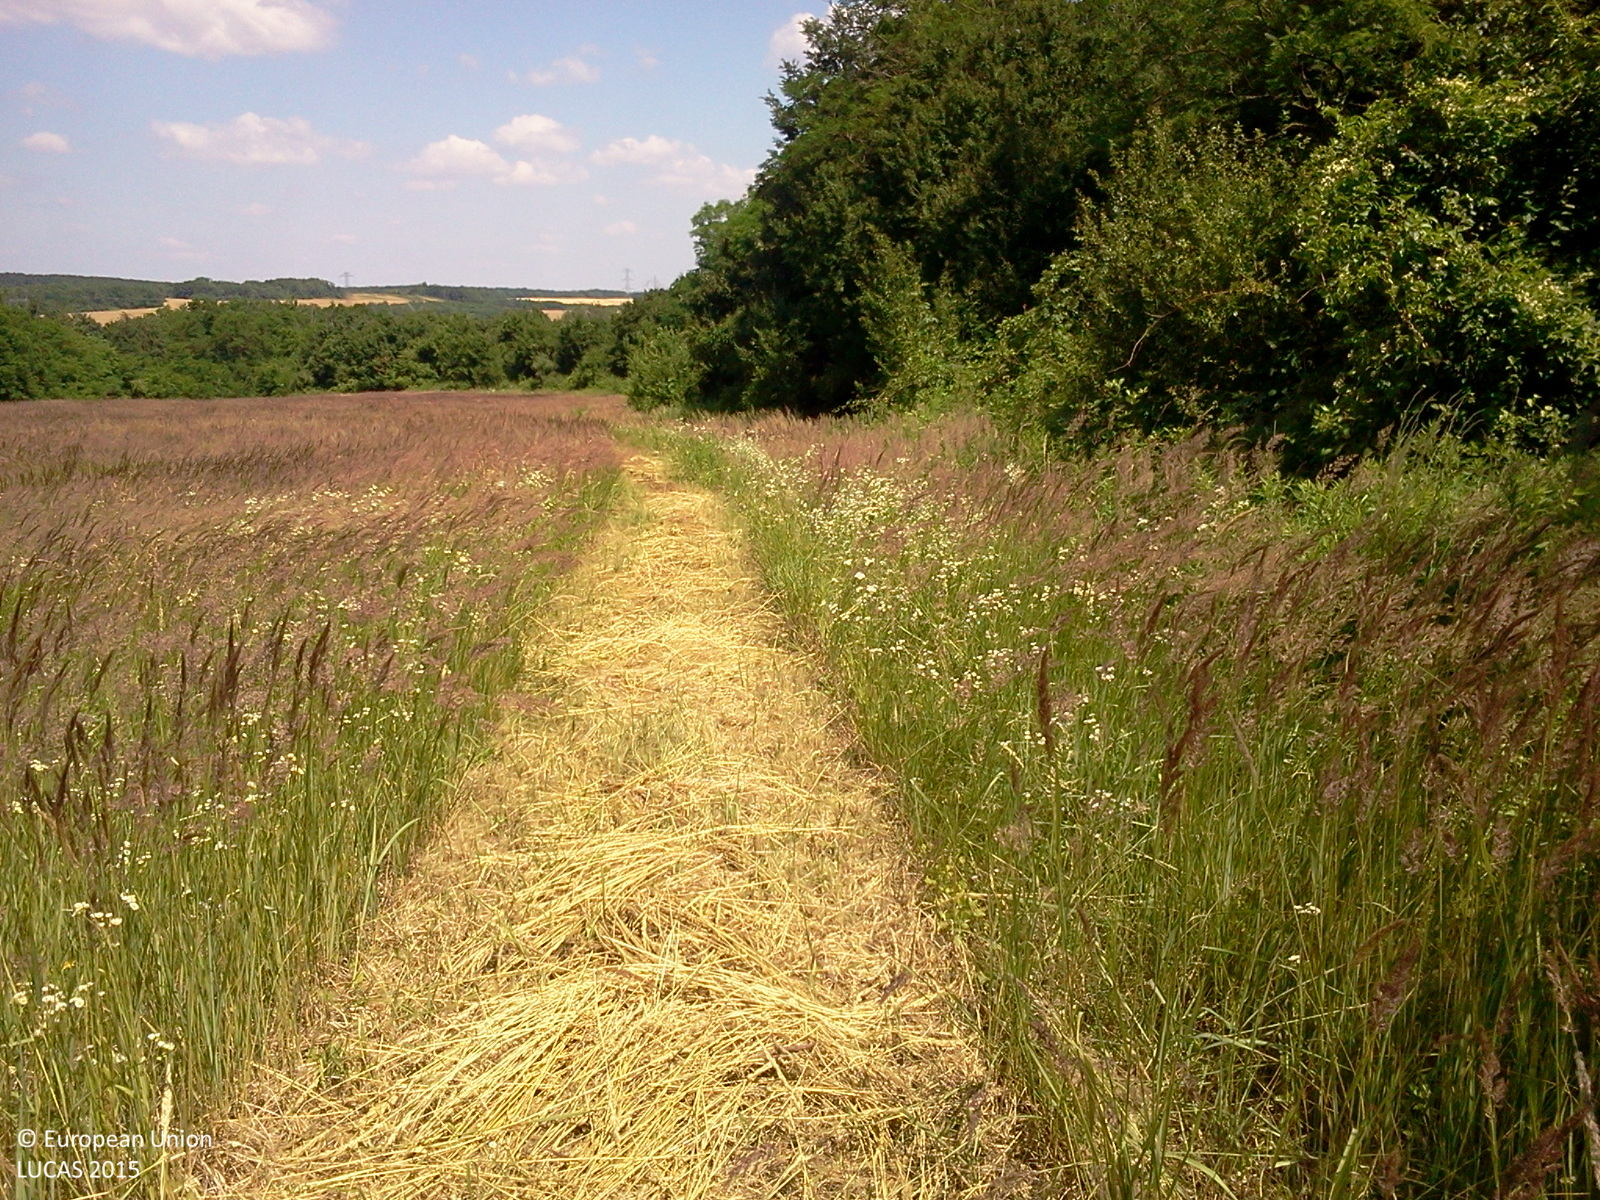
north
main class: Grassland
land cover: Grassland without tree/shrub cover
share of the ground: > 75 %
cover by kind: herbaceous plants 100 %
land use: Agriculture (excluding fallow land and kitchen gardens)
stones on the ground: < 10 %
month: June
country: HU
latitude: 46.7667
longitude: 17.0880
